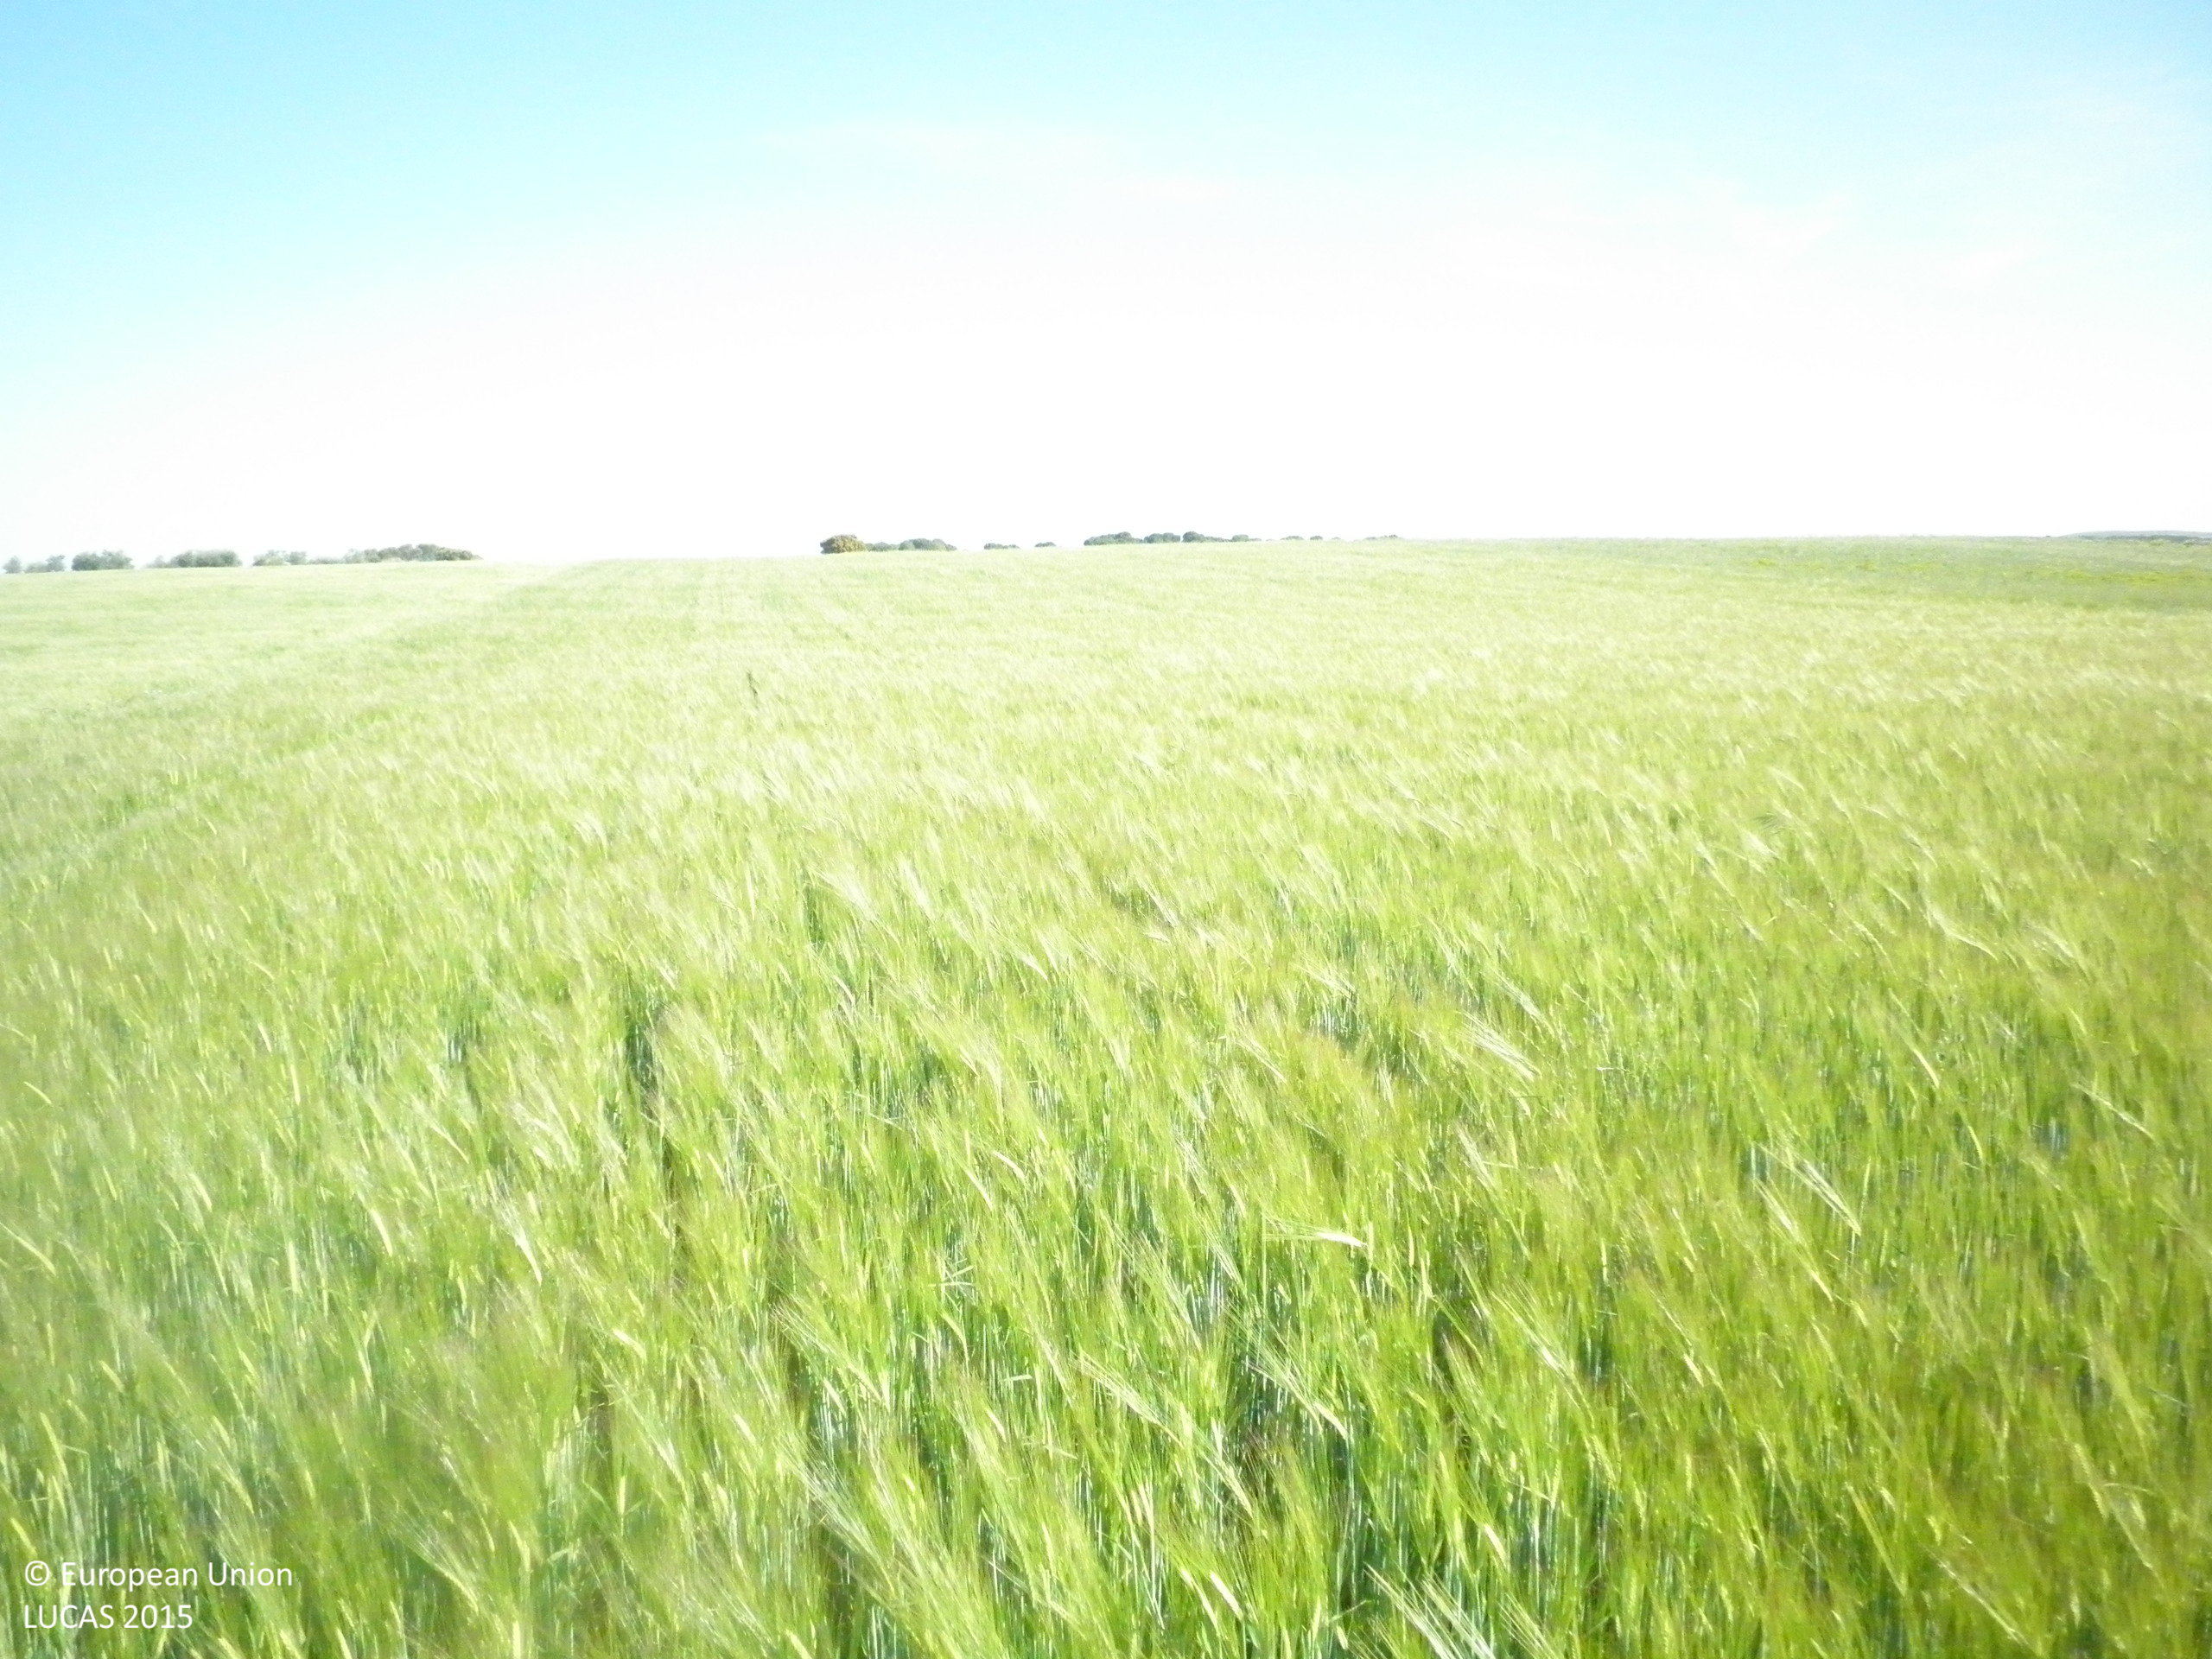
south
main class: Cropland
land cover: Barley
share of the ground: > 75 %
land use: Agriculture (excluding fallow land and kitchen gardens)
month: May
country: ES
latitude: 39.6716
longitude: -2.7351
